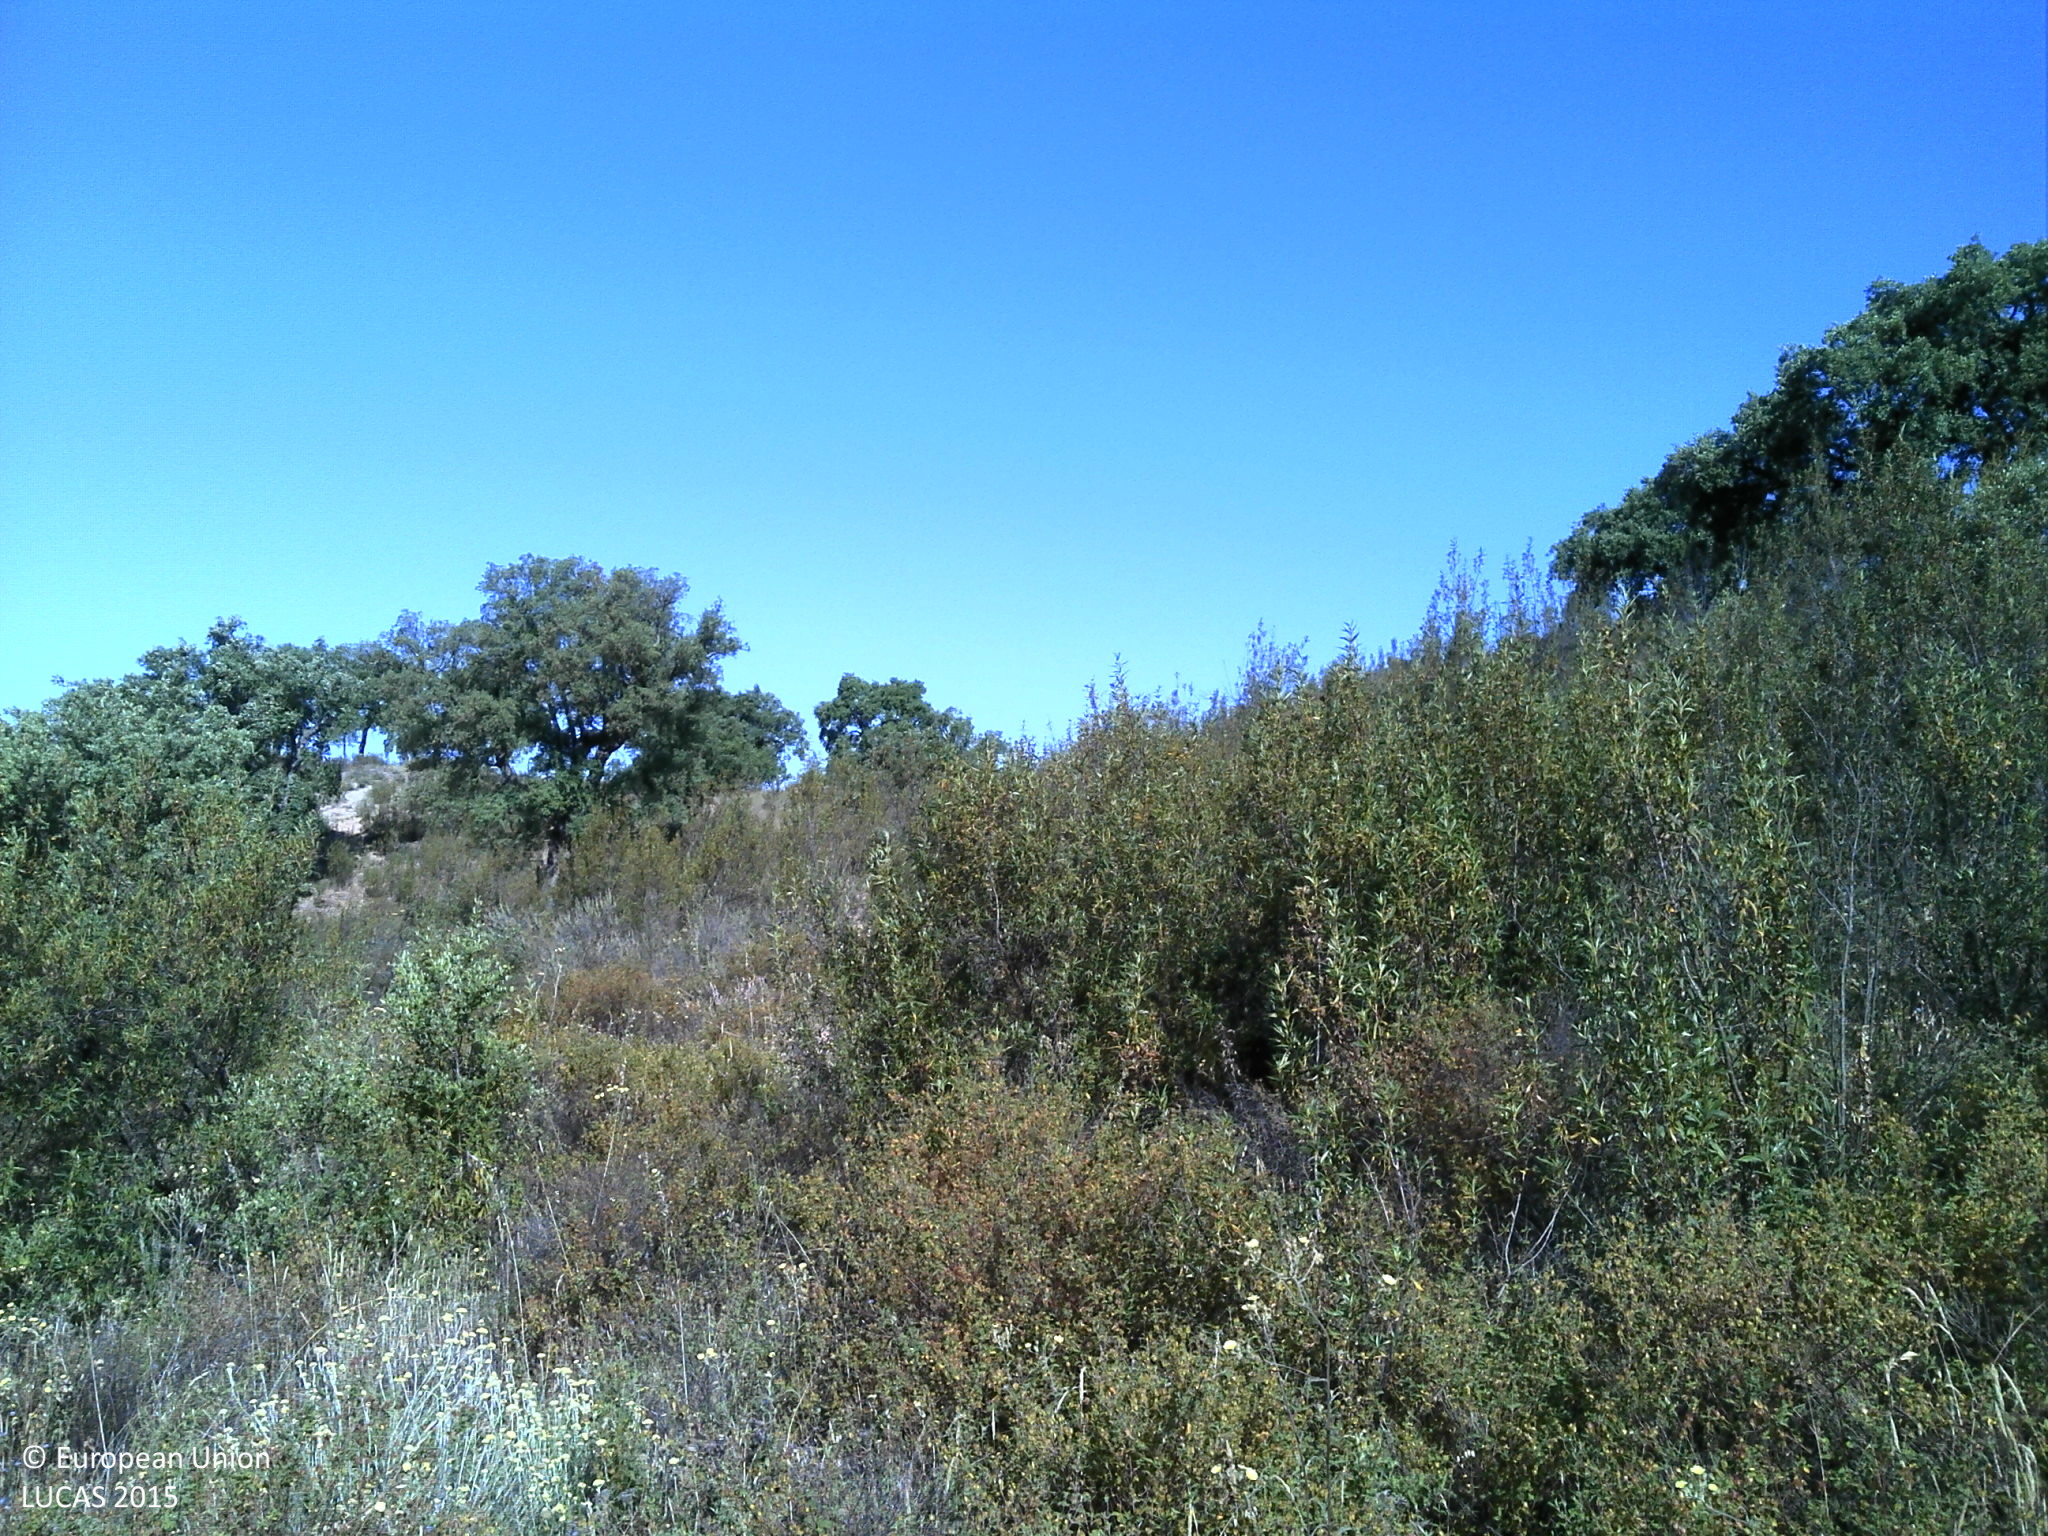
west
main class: Woodland
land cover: Broadleaved woodland
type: broadleaved evergreen forest
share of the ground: 10 - 25 %
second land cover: Shrubland without tree cover
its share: 50 - 75 %
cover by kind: shrubs 50 %, unconsolidated bare surface 25 %, broadleaved forest trees 15 %, herbaceous plants 10 %
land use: Forestry
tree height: > 5 m
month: May
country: PT
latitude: 39.2122
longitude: -8.0170
